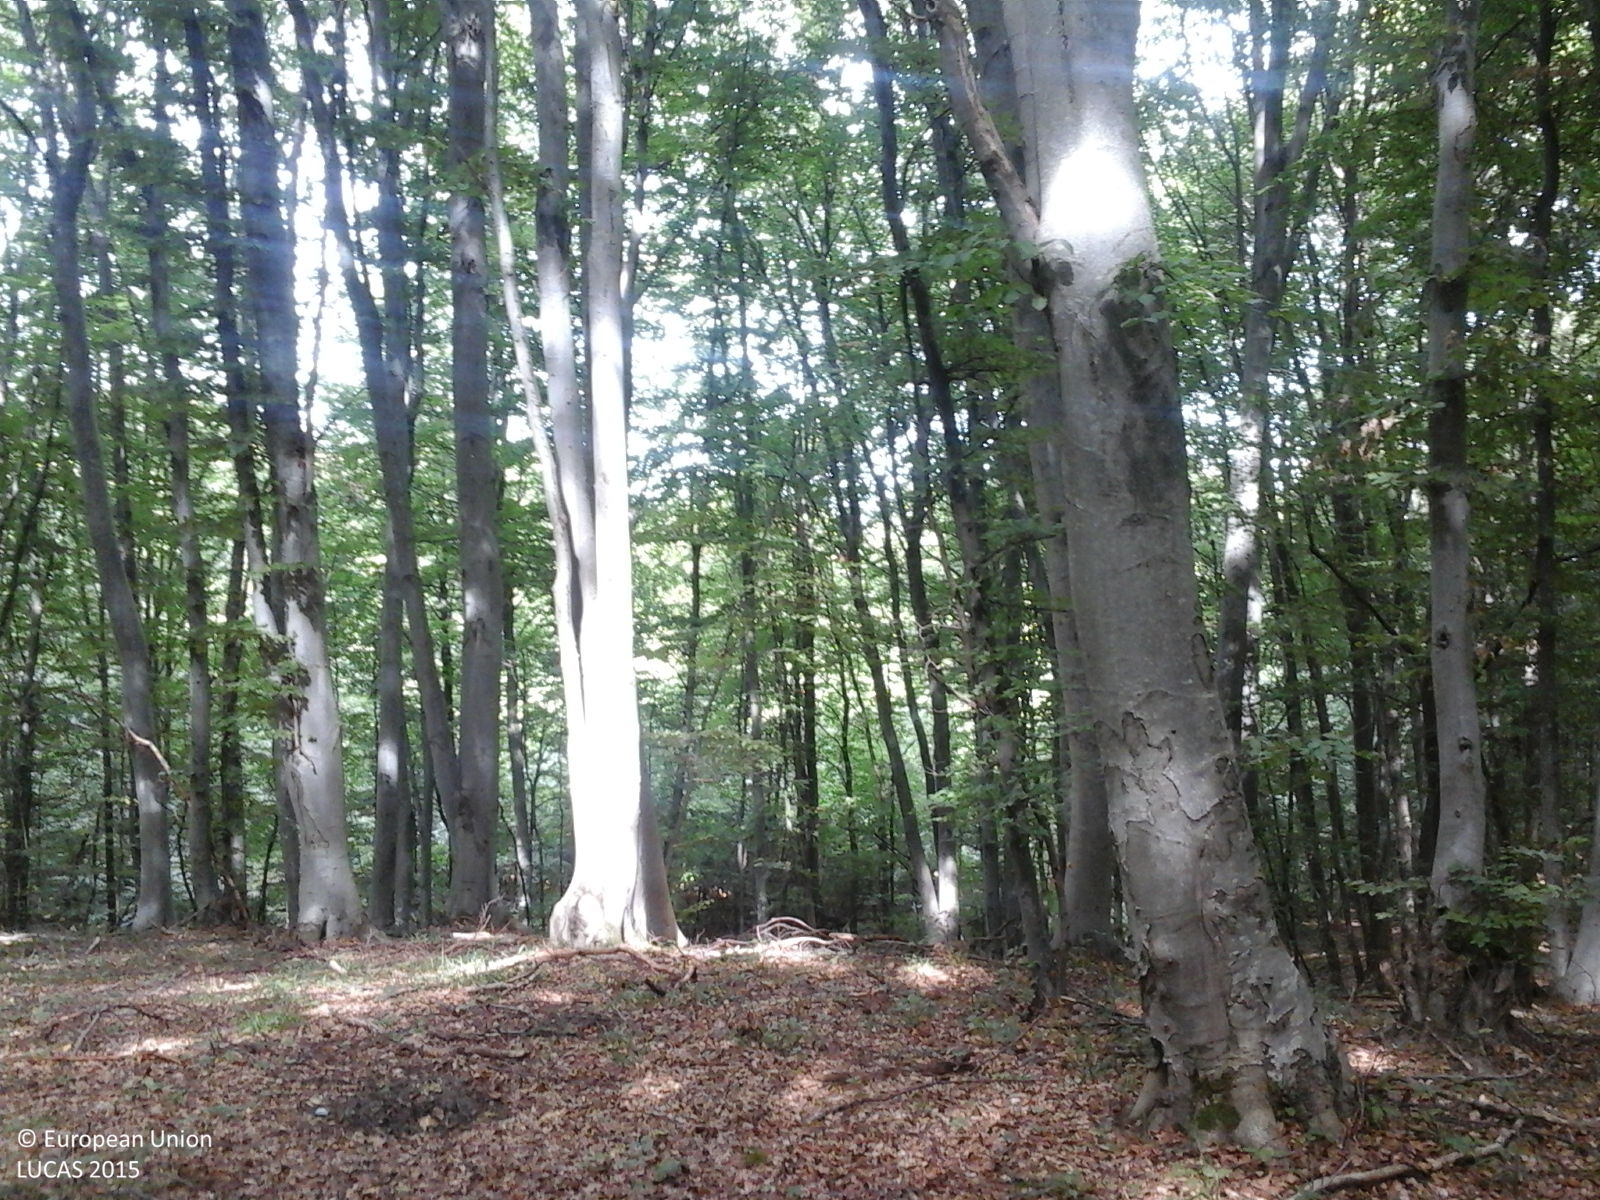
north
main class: Woodland
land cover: Broadleaved woodland
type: beech forest
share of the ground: > 75 %
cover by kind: broadleaved forest trees 100 %
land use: Forestry
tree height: > 5 m
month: September
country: RO
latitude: 46.7064
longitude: 23.5552
